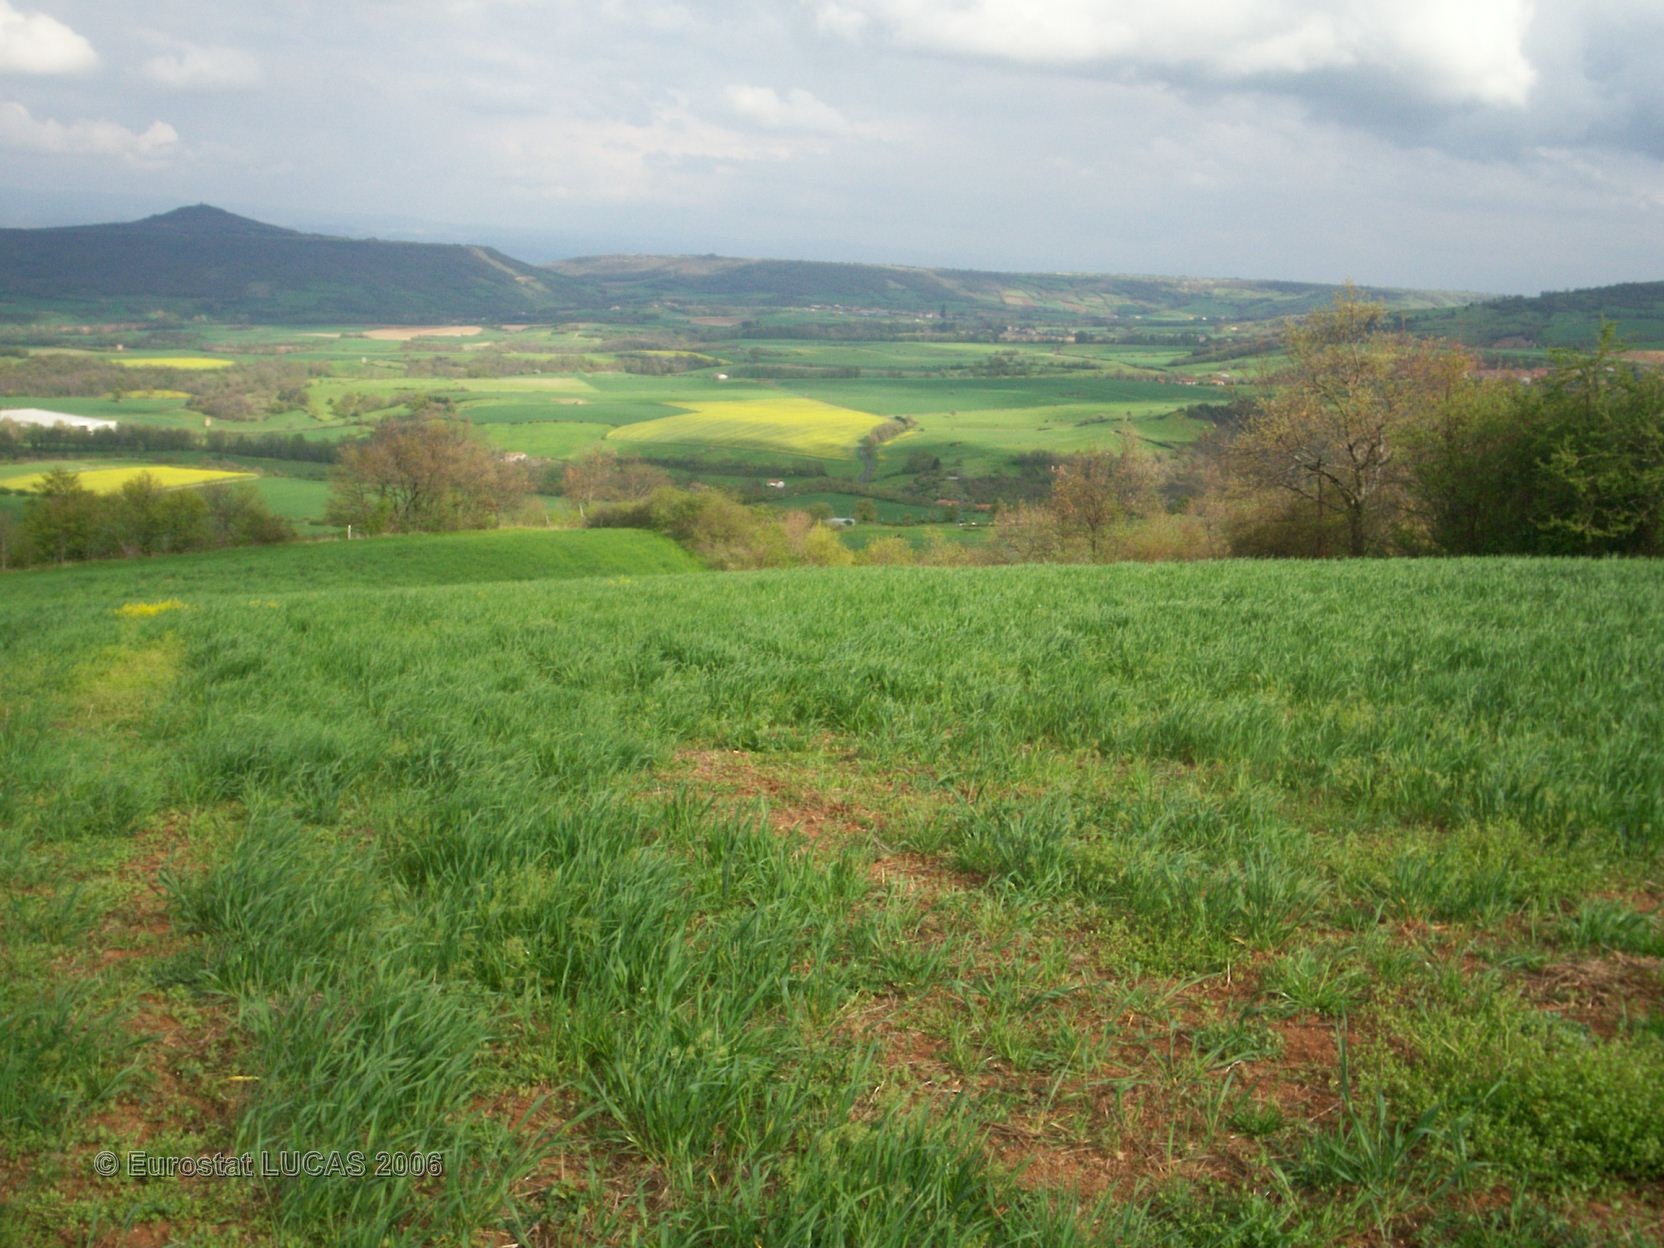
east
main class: Grassland
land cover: Grassland without tree/shrub cover
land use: Agriculture (excluding fallow land and kitchen gardens)
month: April
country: FR
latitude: 45.4273
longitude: 3.1631
